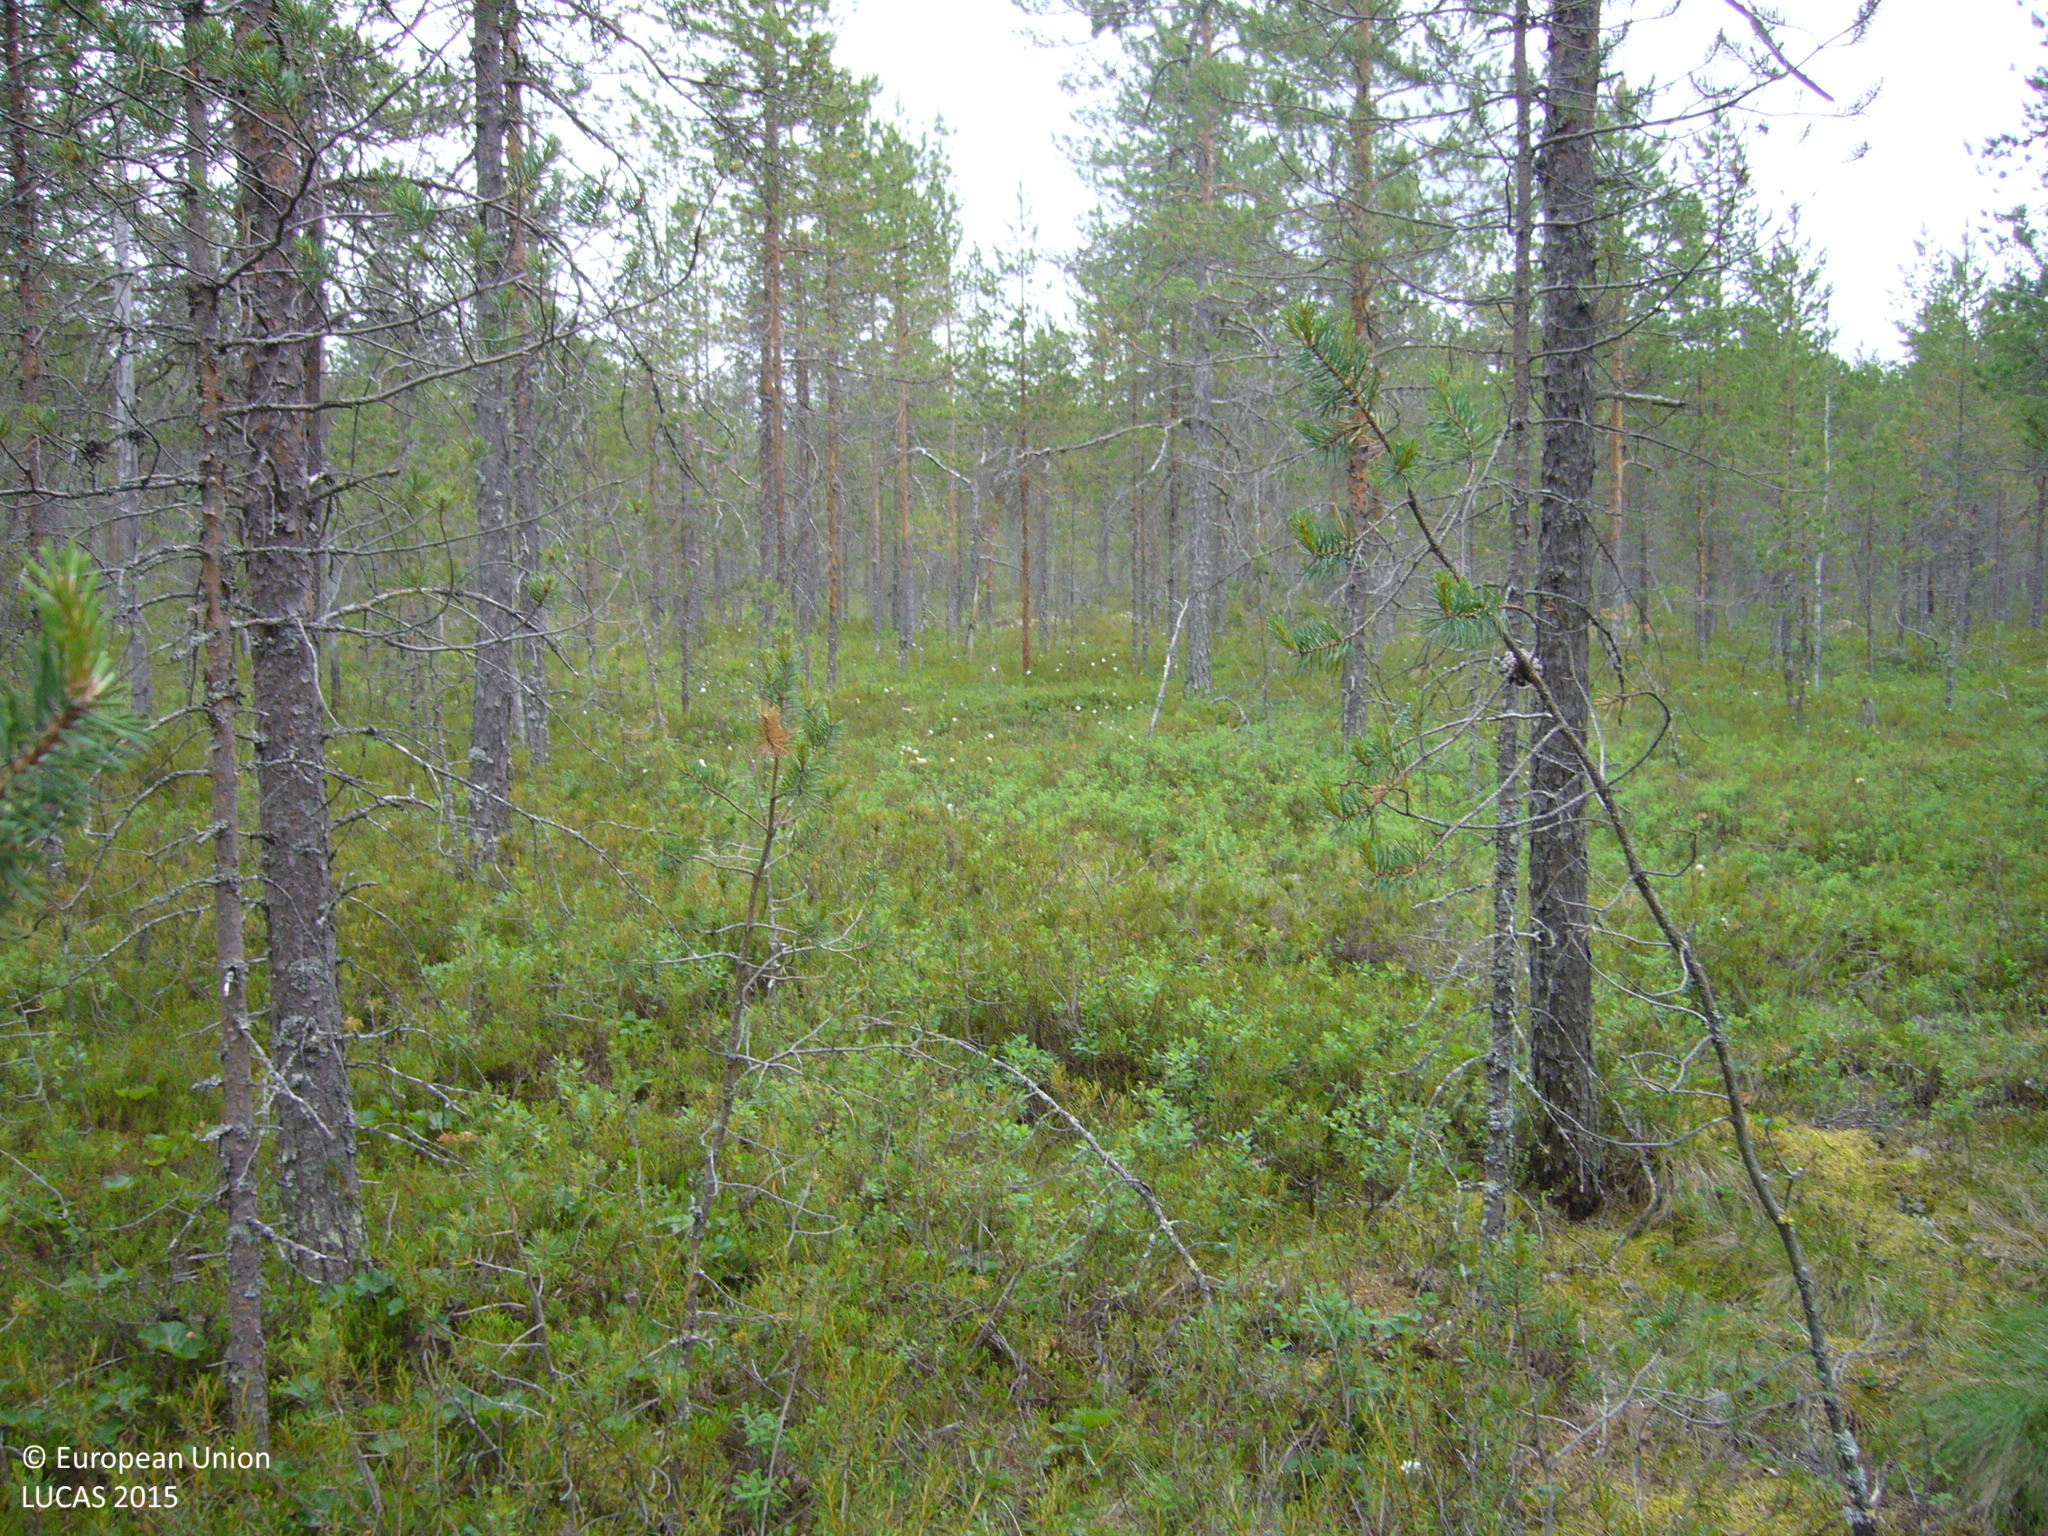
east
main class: Woodland
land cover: Pine dominated coniferous woodland
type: boreal forest
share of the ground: 50 - 75 %
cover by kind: coniferous forest trees 60 %, shrubs 40 %
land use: Forestry
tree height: > 5 m
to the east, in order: Pine dominated coniferous woodland; Ditches and canals; Pine dominated coniferous woodland; Ditches and canals; Pine dominated coniferous woodland; Ditches and canals; Pine dominated coniferous woodland; Spruce dominated mixed woodland; Ditches and canals; Shruby margins; Tracks
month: July
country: FI
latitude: 63.4635
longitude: 25.8593
